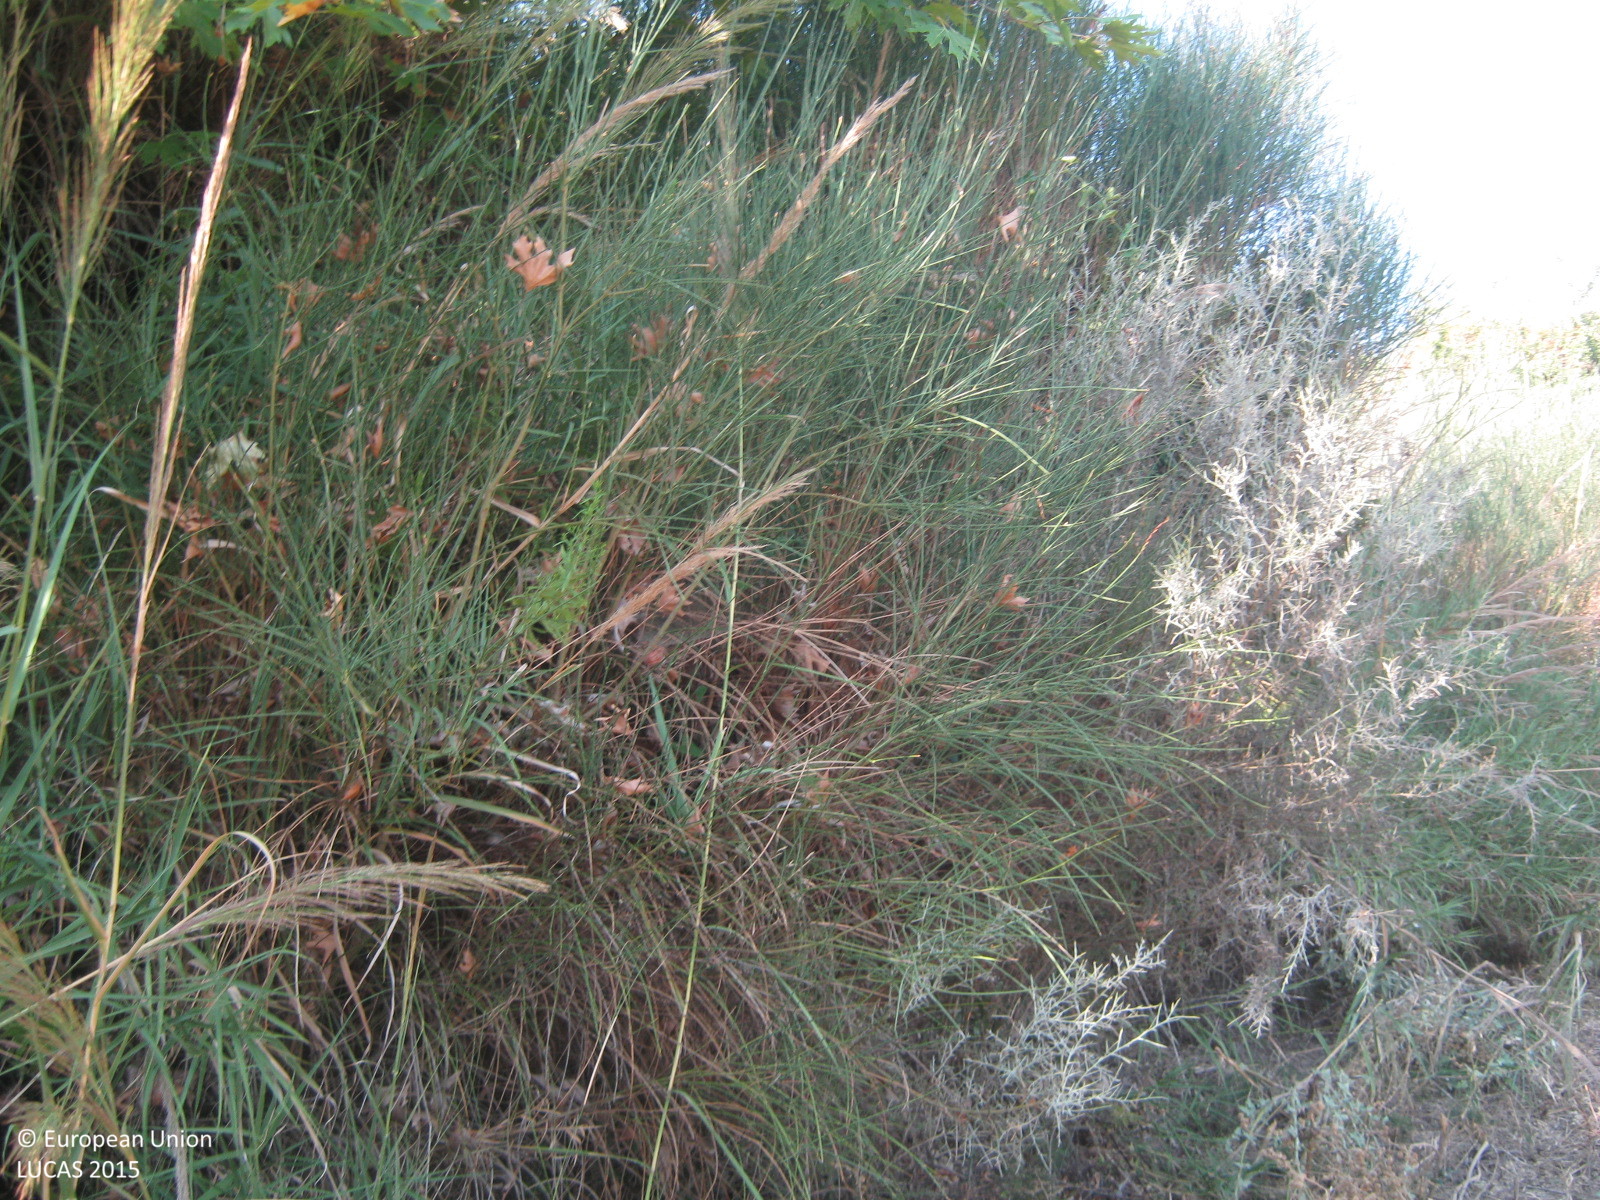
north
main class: Shrubland
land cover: Shrubland with sparse tree cover
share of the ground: > 75 %
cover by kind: shrubs 90 %, coniferous forest trees 5 %, herbaceous plants 5 %
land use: Semi-natural and natural areas not in use
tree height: < 5 m
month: September
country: GR
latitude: 37.8034
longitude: 21.6027
